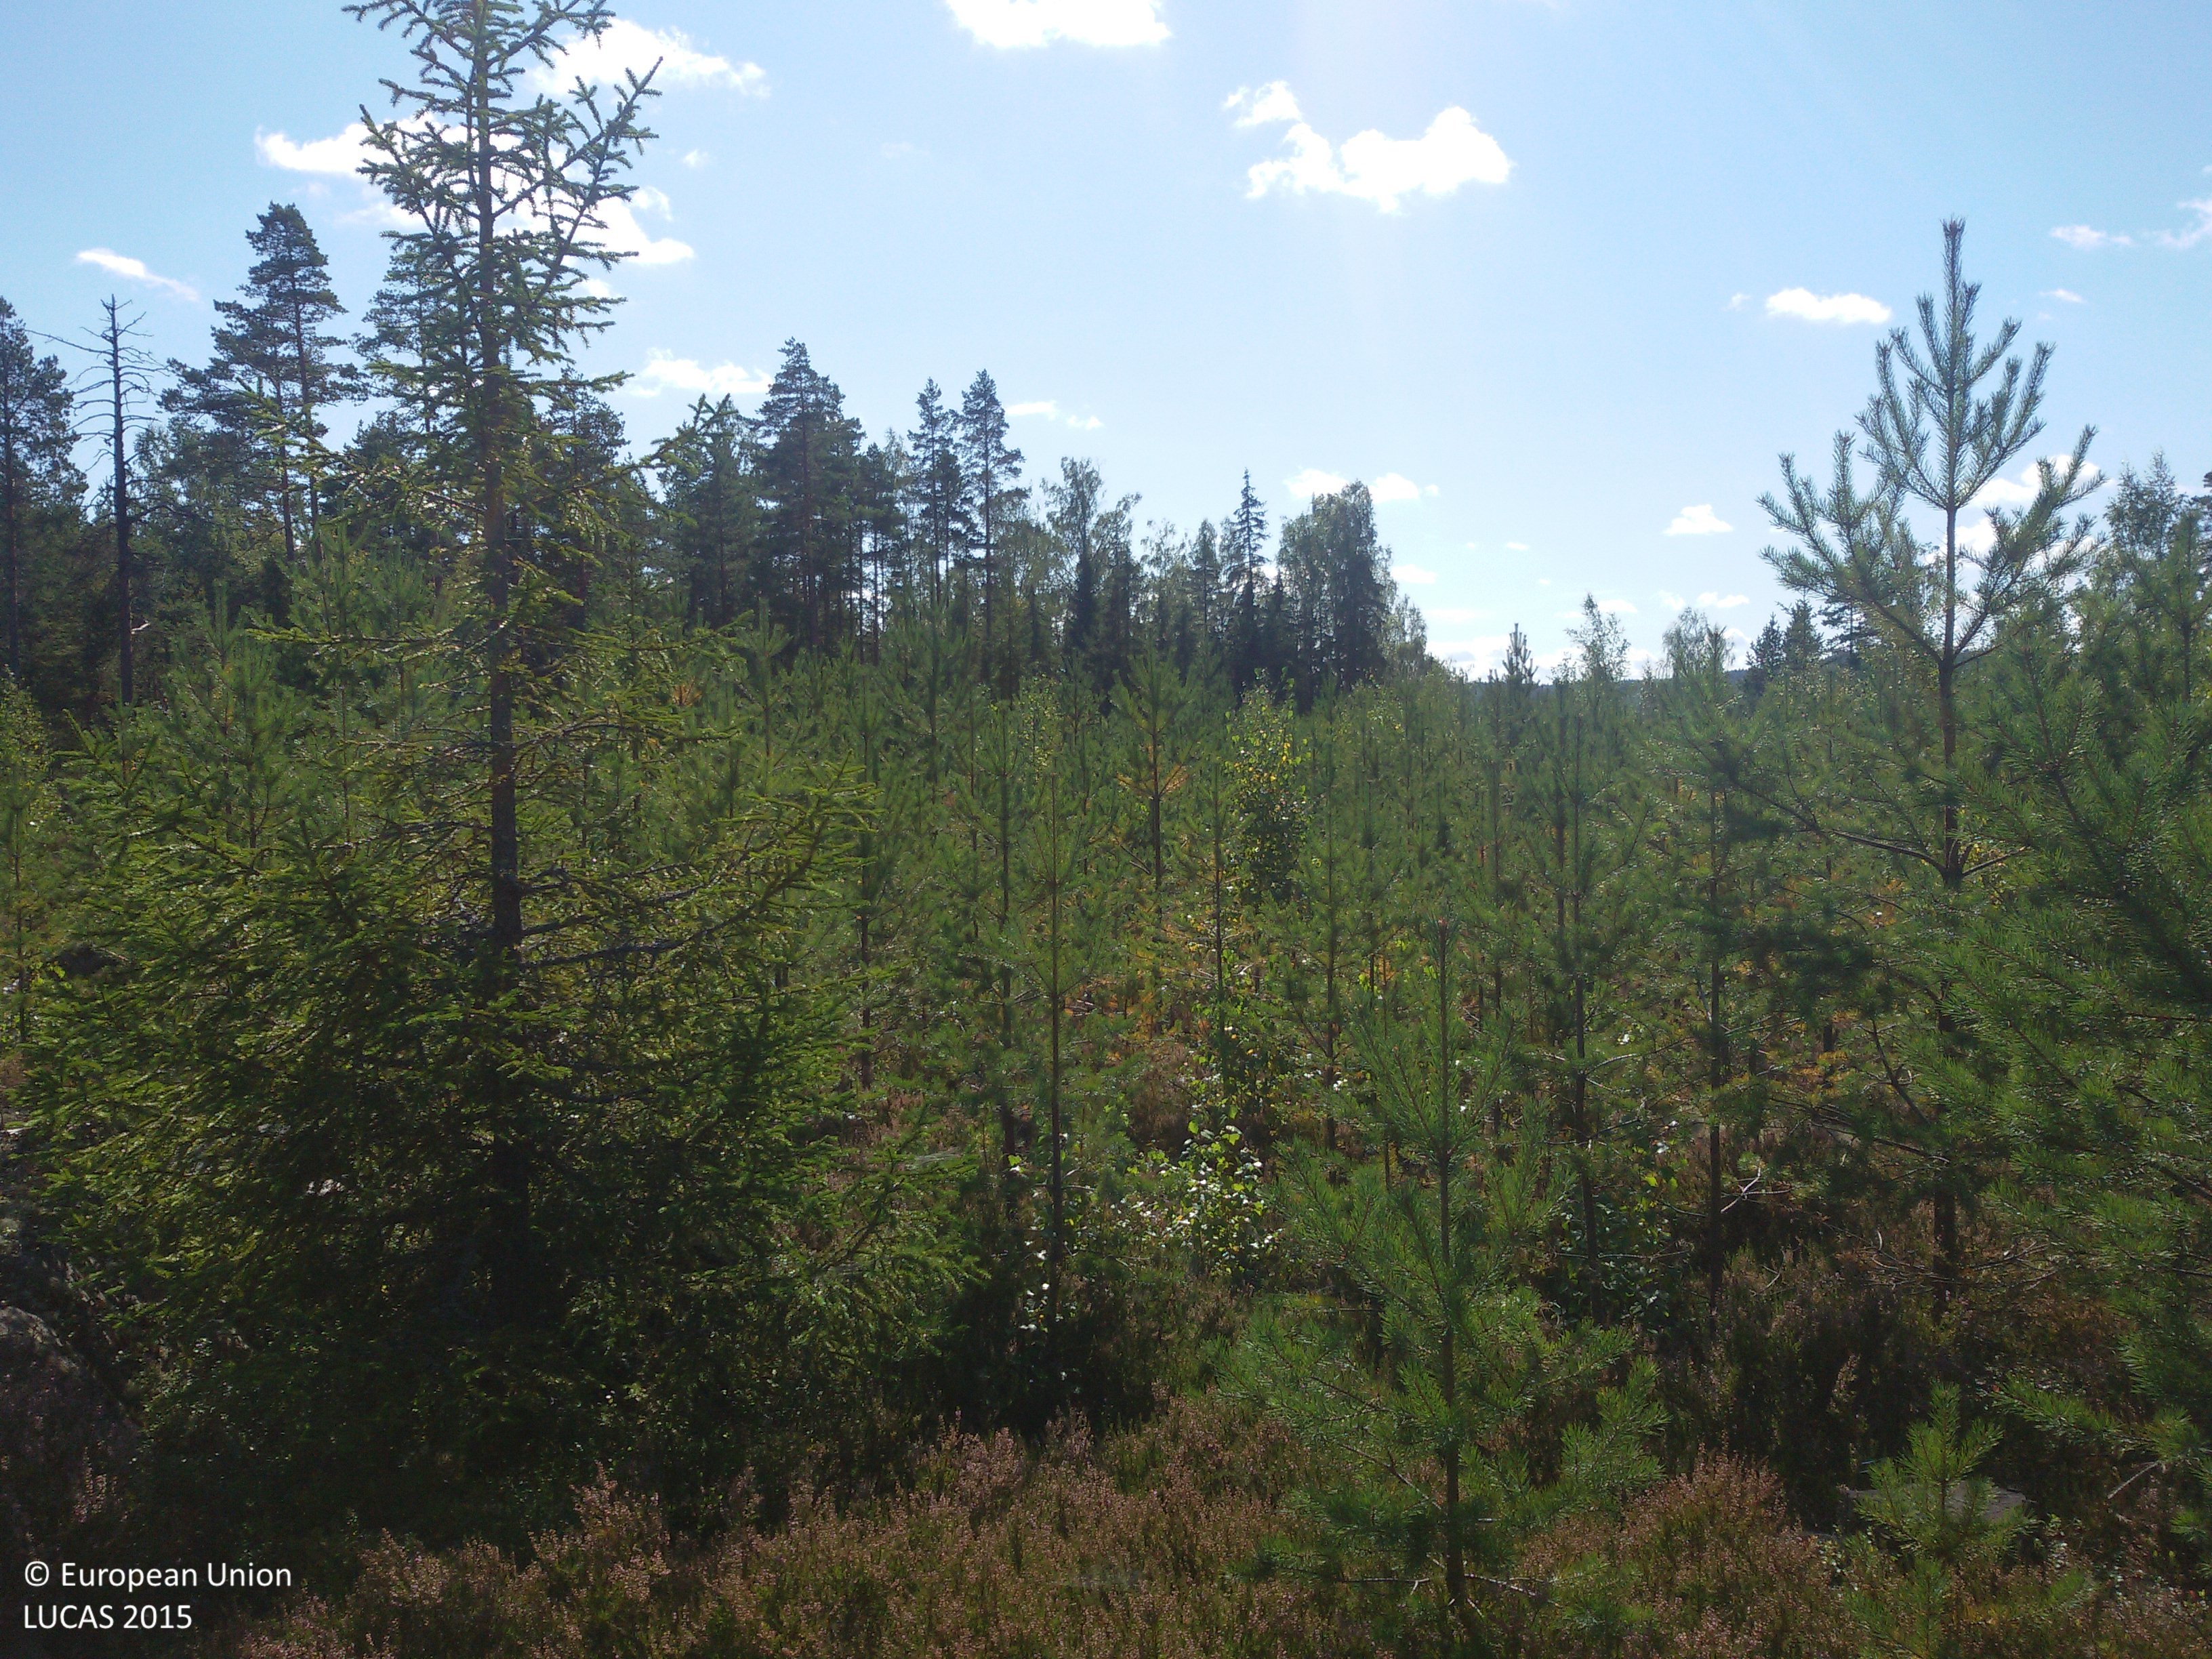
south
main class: Woodland
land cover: Pine dominated coniferous woodland
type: boreal forest
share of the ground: 50 - 75 %
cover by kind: coniferous forest trees 60 %, herbaceous plants 20 %, broadleaved forest trees 10 %, lichens and mosses 10 %
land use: Forestry
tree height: < 5 m
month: August
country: SE
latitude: 60.6608
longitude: 15.7139
